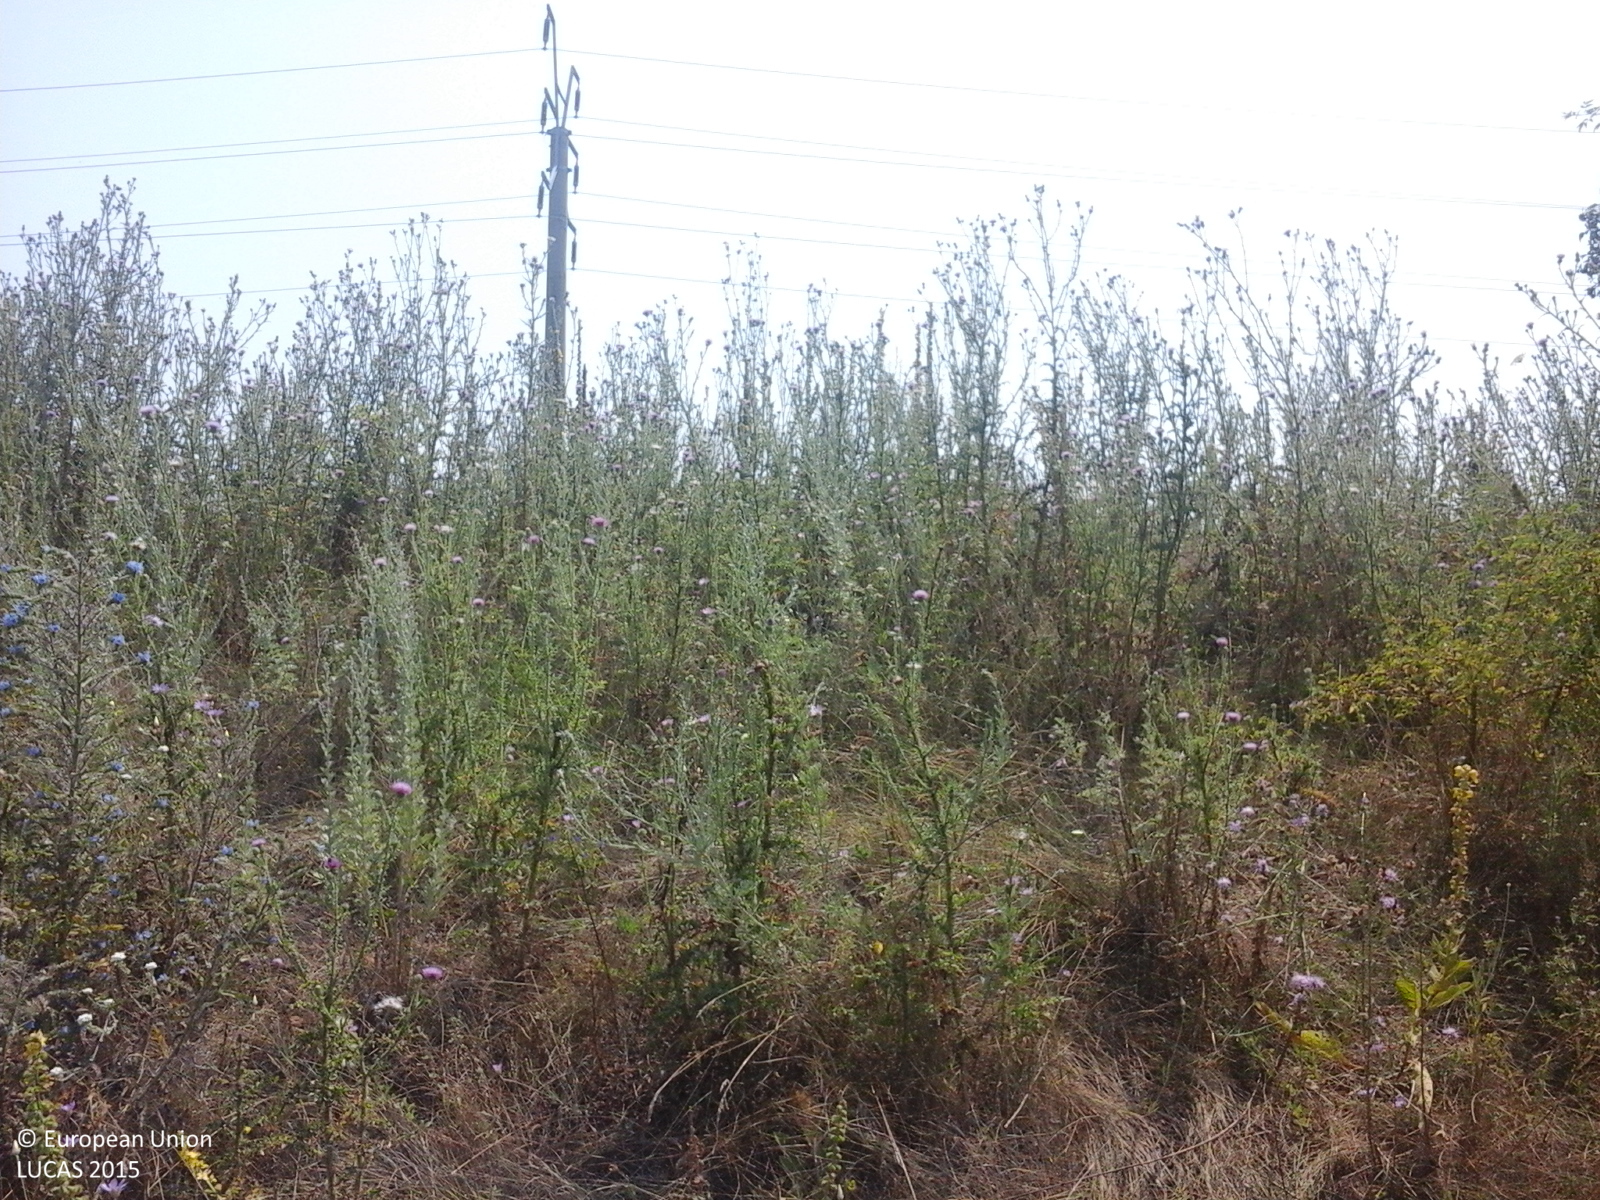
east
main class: Grassland
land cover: Grassland with sparse tree/shrub cover
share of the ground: > 75 %
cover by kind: herbaceous plants 85 %, shrubs 10 %, broadleaved forest trees 5 %
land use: Agriculture (excluding fallow land and kitchen gardens)
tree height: < 5 m
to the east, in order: Grassland with sparse tree/shrub cover; Tracks; Maize; Electric lines; Maize
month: July
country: RO
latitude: 44.6585
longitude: 26.4733
